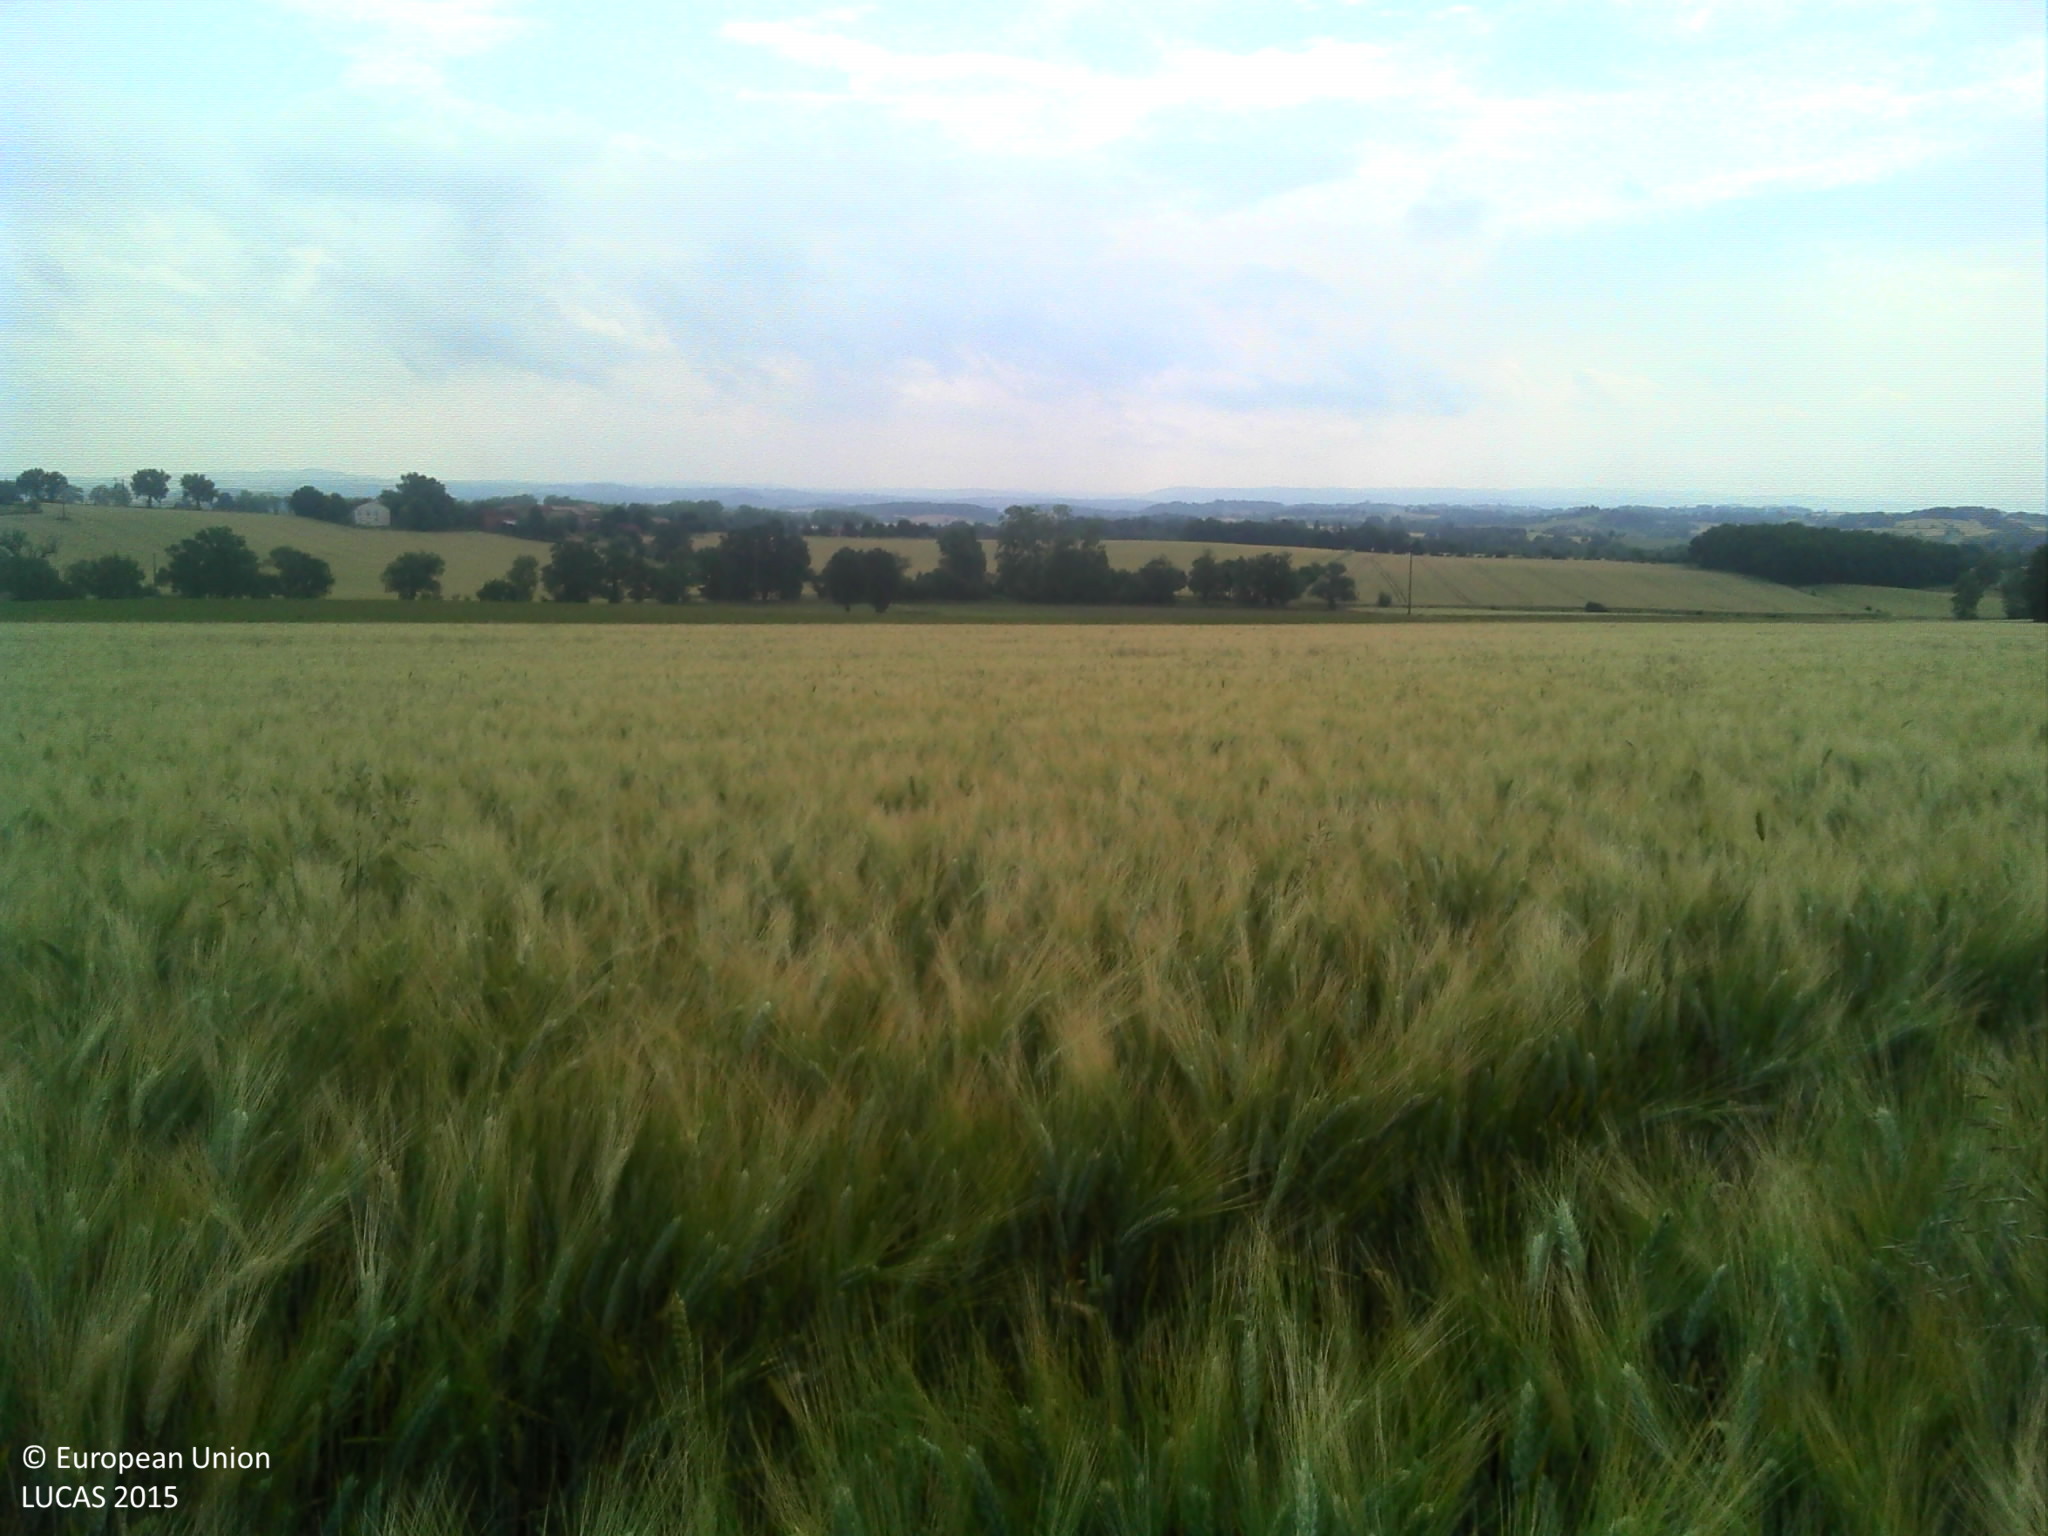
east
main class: Cropland
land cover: Common wheat
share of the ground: > 75 %
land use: Agriculture (excluding fallow land and kitchen gardens)
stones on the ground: 10 - 25 %
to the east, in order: Common wheat; Tracks; Sunflower
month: June
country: FR
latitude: 43.6888
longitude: 2.1270
